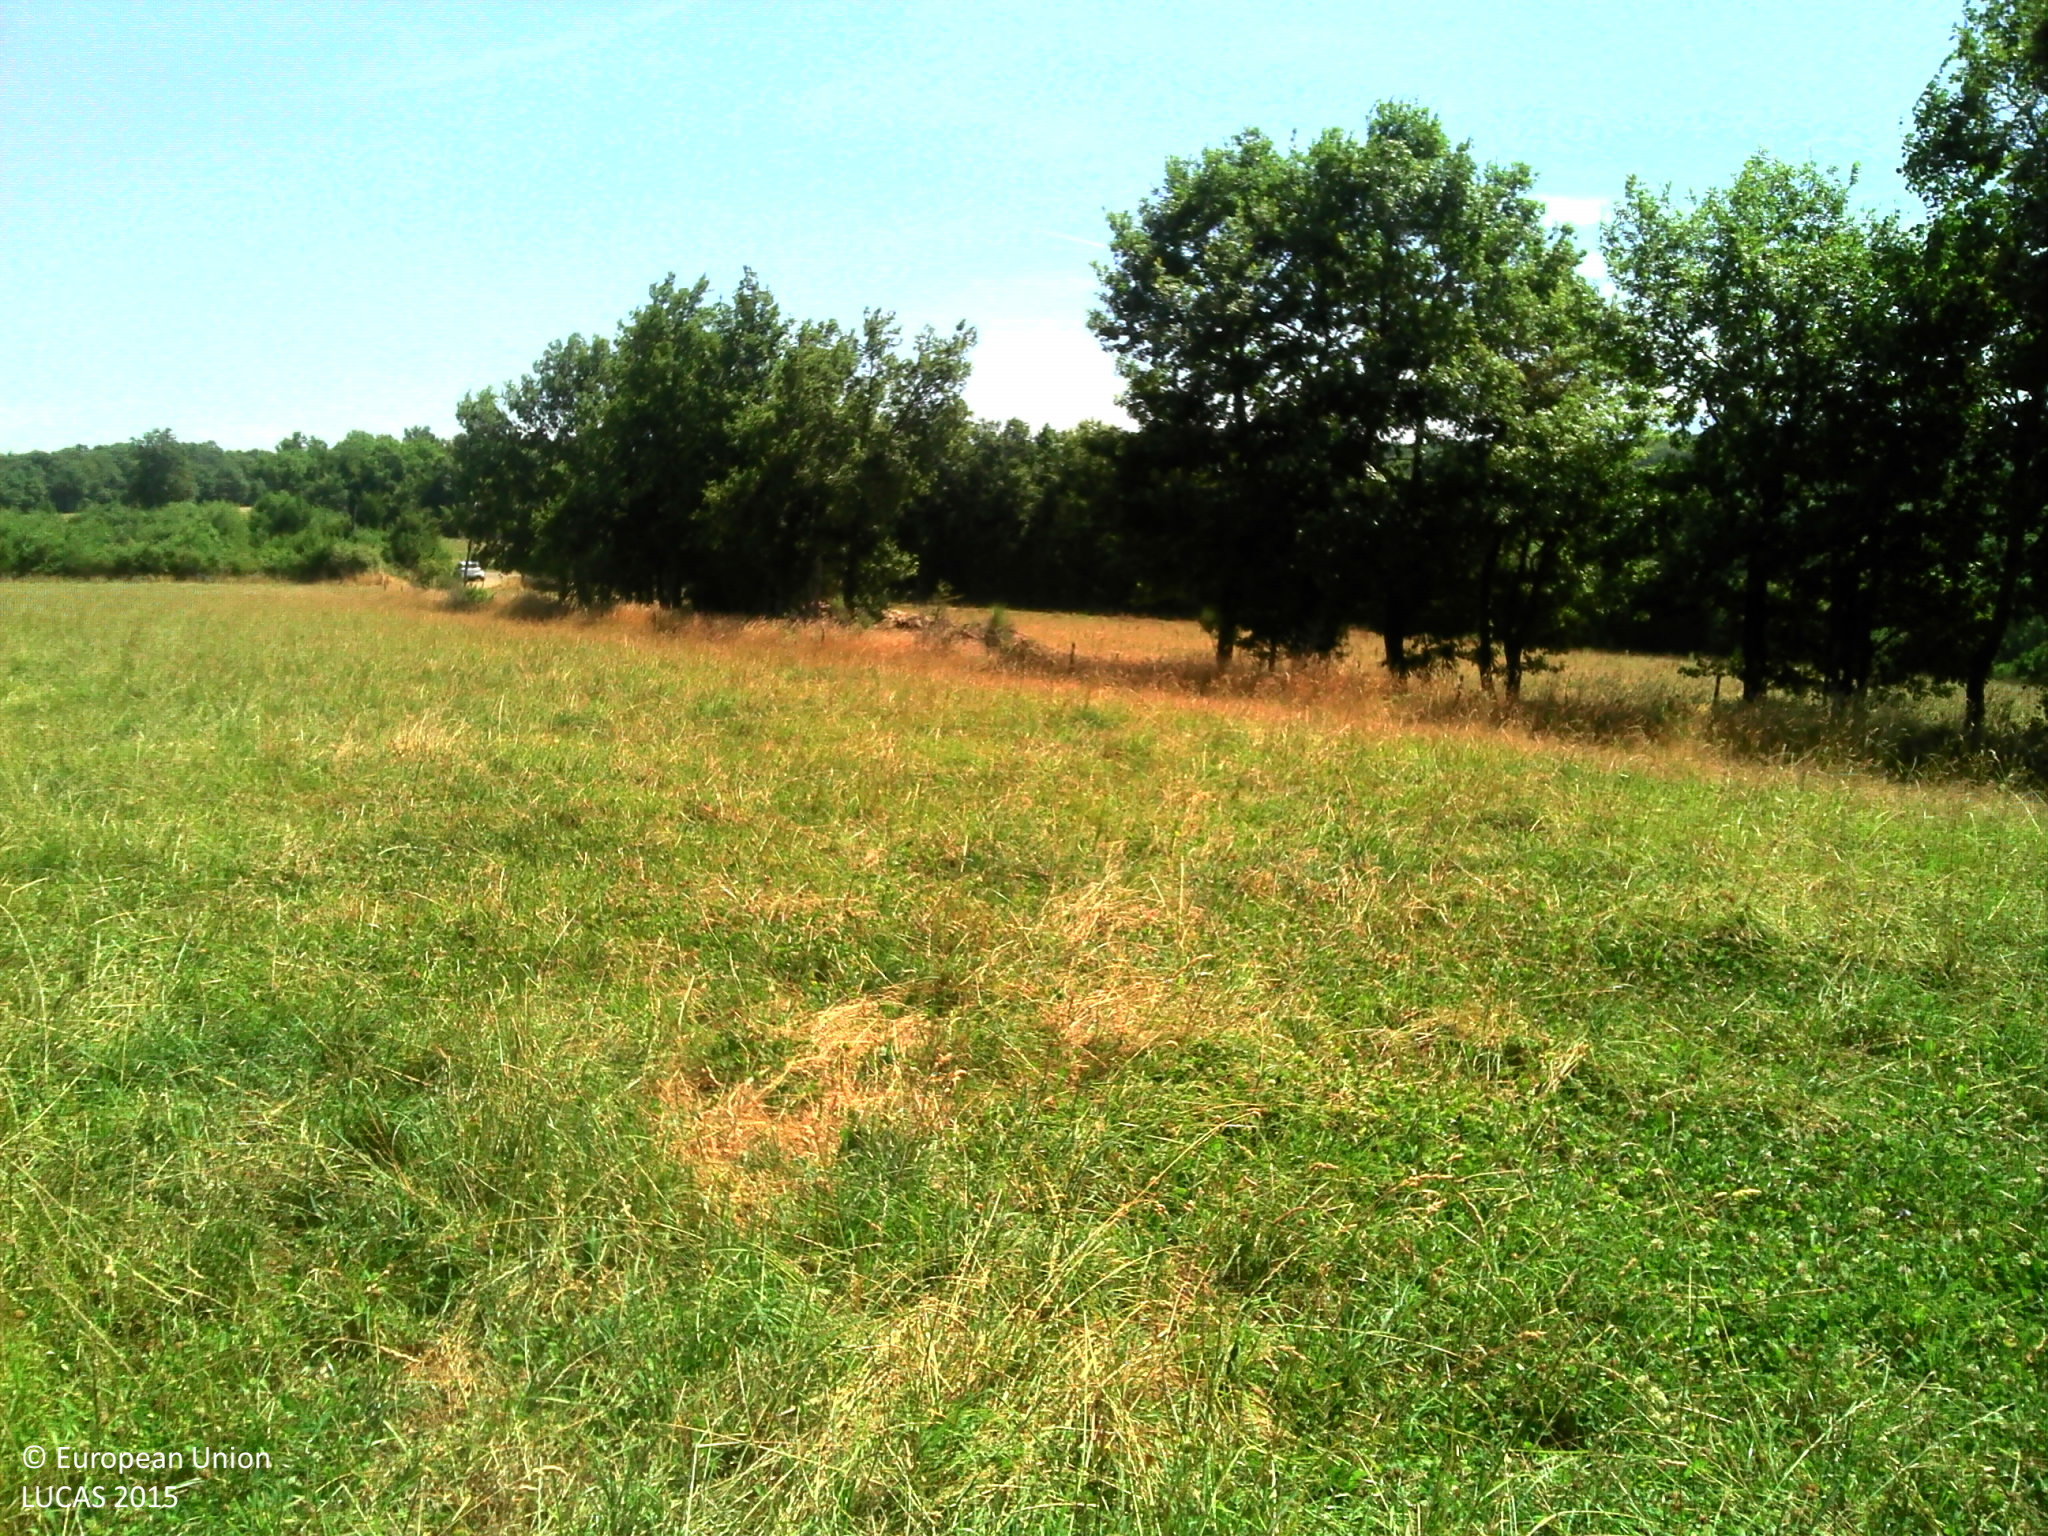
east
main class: Grassland
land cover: Grassland without tree/shrub cover
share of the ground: > 75 %
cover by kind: herbaceous plants 100 %
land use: Agriculture (excluding fallow land and kitchen gardens)
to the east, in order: Grassland without tree/shrub cover; Fences; Tracks; Lines of trees; Fences; Grassland without tree/shrub cover; Ditches and canals; Paved roads, cycling and walking lanes; Broadleaved woodland; Grassland without tree/shrub cover; Fences; Shrubland with sparse tree cover; Grassland without tree/shrub cover
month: July
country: FR
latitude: 45.2689
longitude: 5.2000
